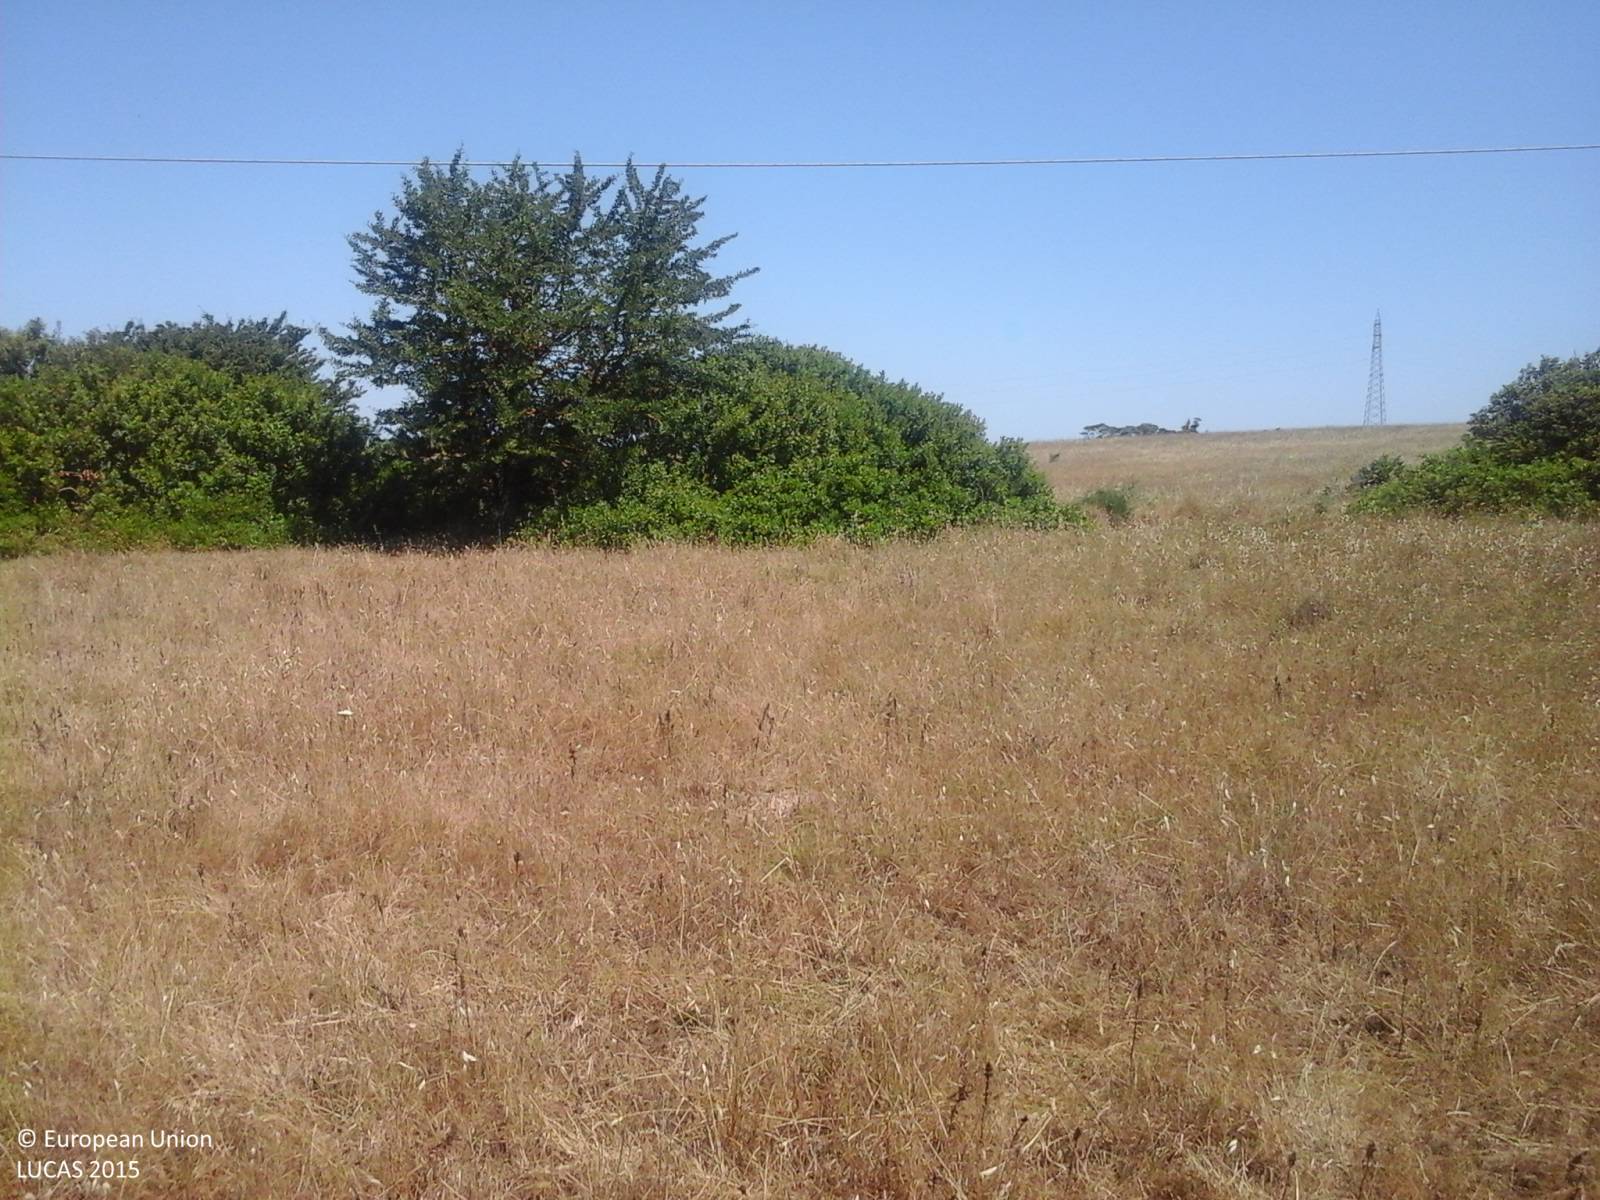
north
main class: Grassland
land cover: Grassland without tree/shrub cover
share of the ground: > 75 %
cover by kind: herbaceous plants 95 %, shrubs 5 %
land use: Agriculture (excluding fallow land and kitchen gardens)
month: June
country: IT
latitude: 40.5977
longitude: 8.3655
